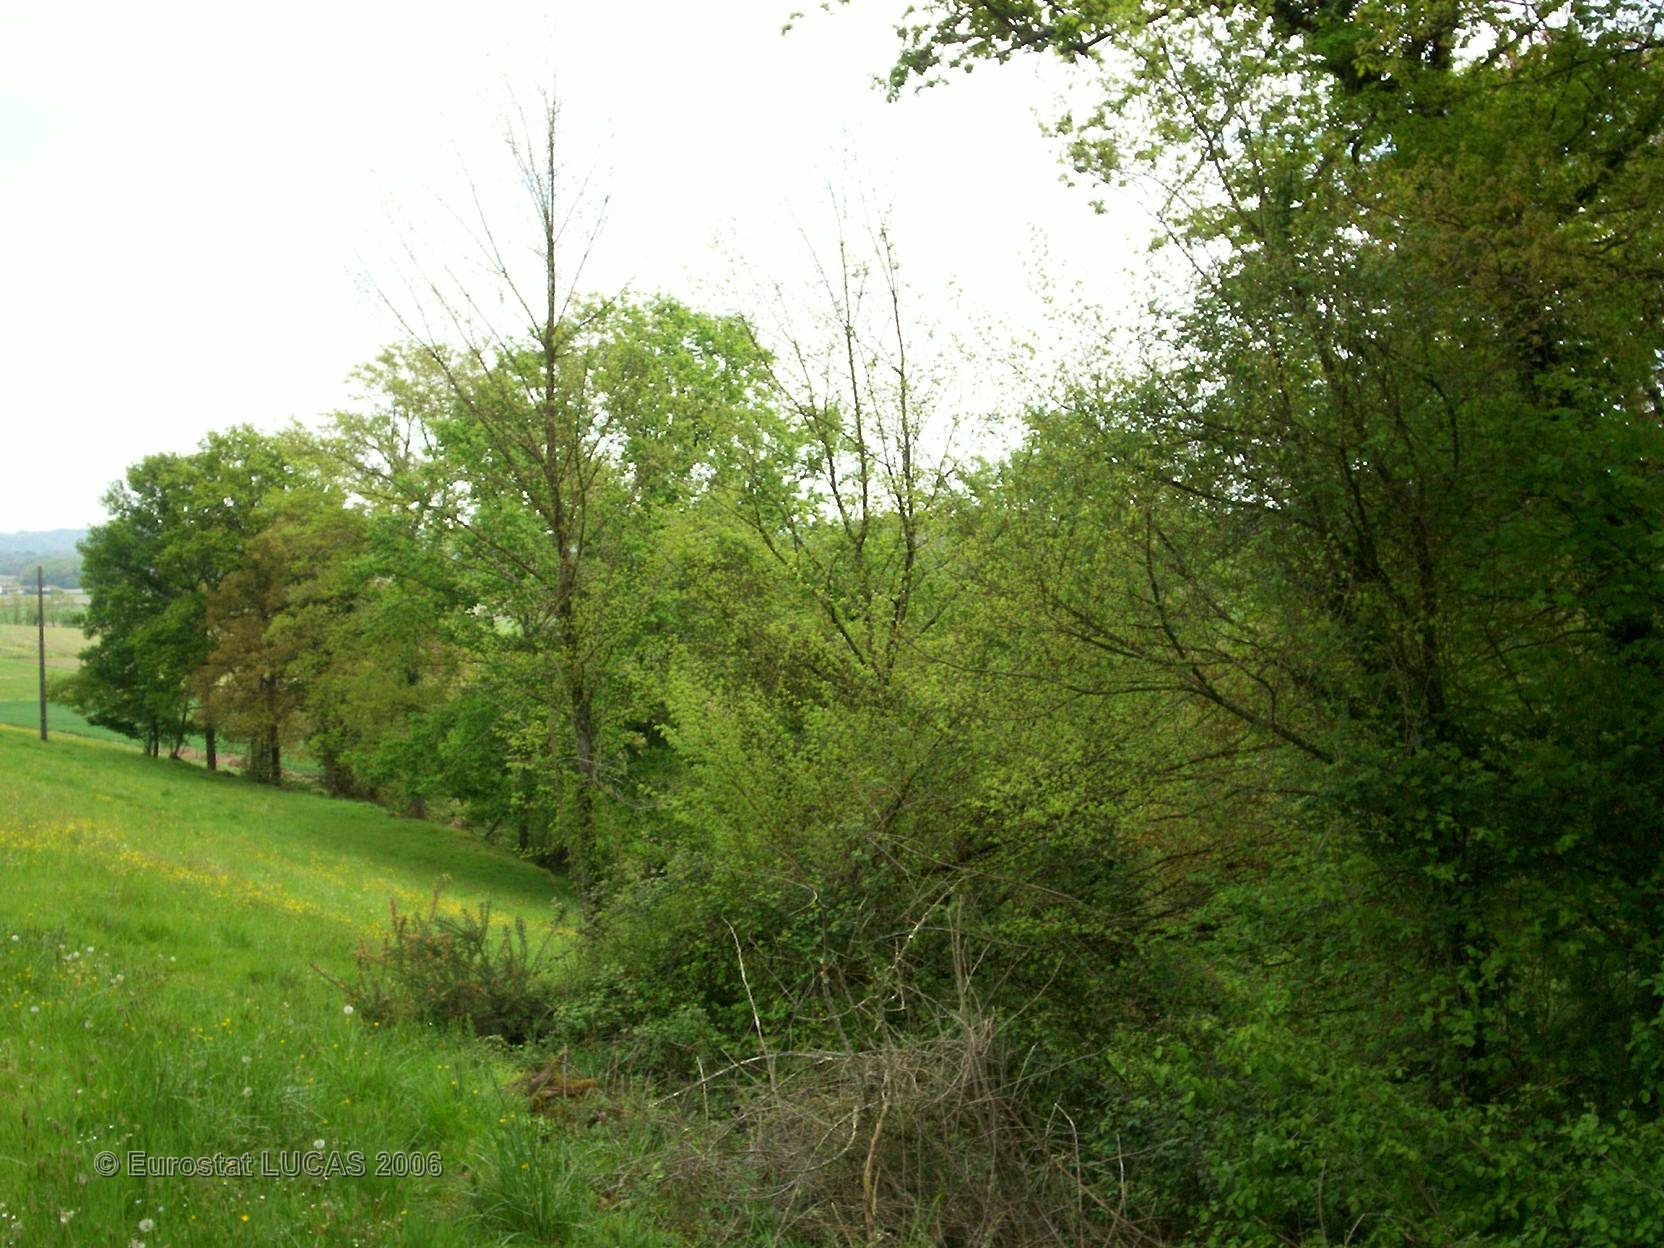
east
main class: Grassland
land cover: Grassland without tree/shrub cover
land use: Agriculture (excluding fallow land and kitchen gardens)
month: April
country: FR
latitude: 43.4911
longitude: -0.6573
